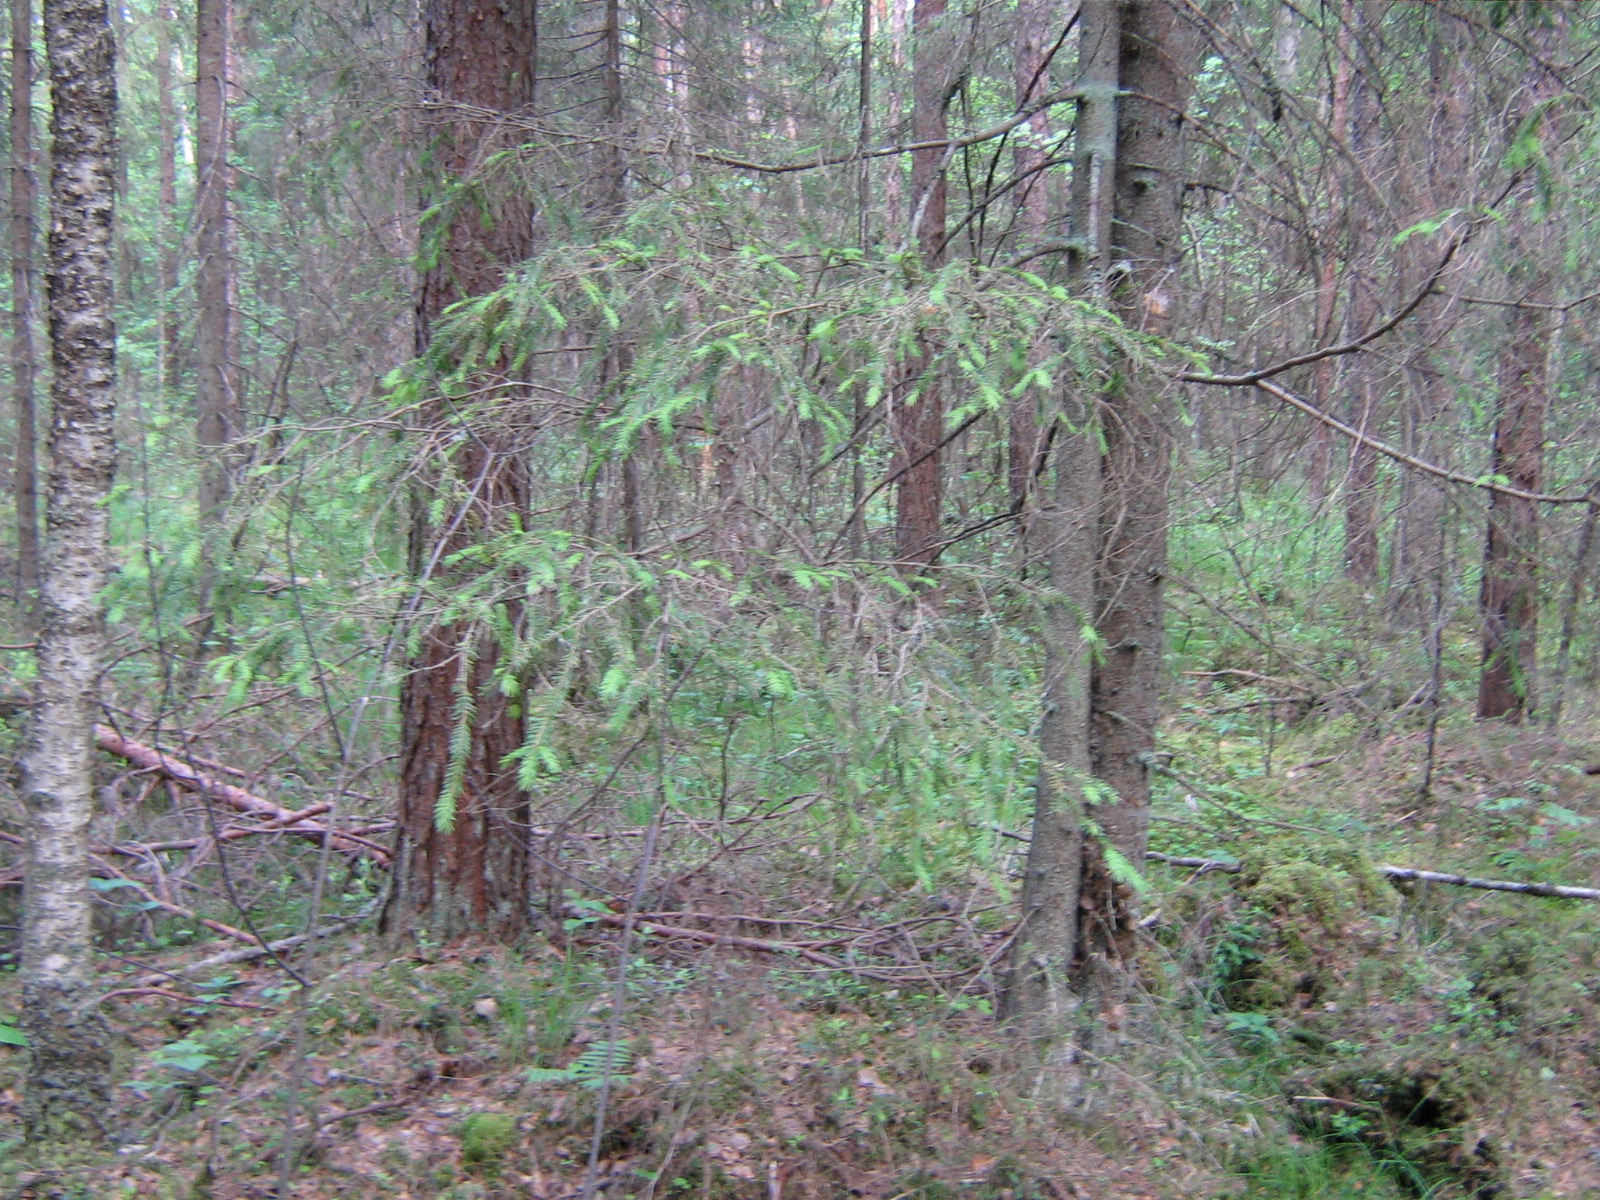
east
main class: Woodland
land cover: Spruce dominated mixed woodland
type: hemiboreal forest and nemoral coniferous forest and mixed broadleaved-coniferous forest
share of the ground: > 75 %
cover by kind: coniferous forest trees 70 %, broadleaved forest trees 30 %
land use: Forestry
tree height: > 5 m
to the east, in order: Spruce dominated mixed woodland; Broadleaved woodland; Ditches and canals; Broadleaved woodland
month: June
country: LV
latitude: 57.1944
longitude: 25.8646
